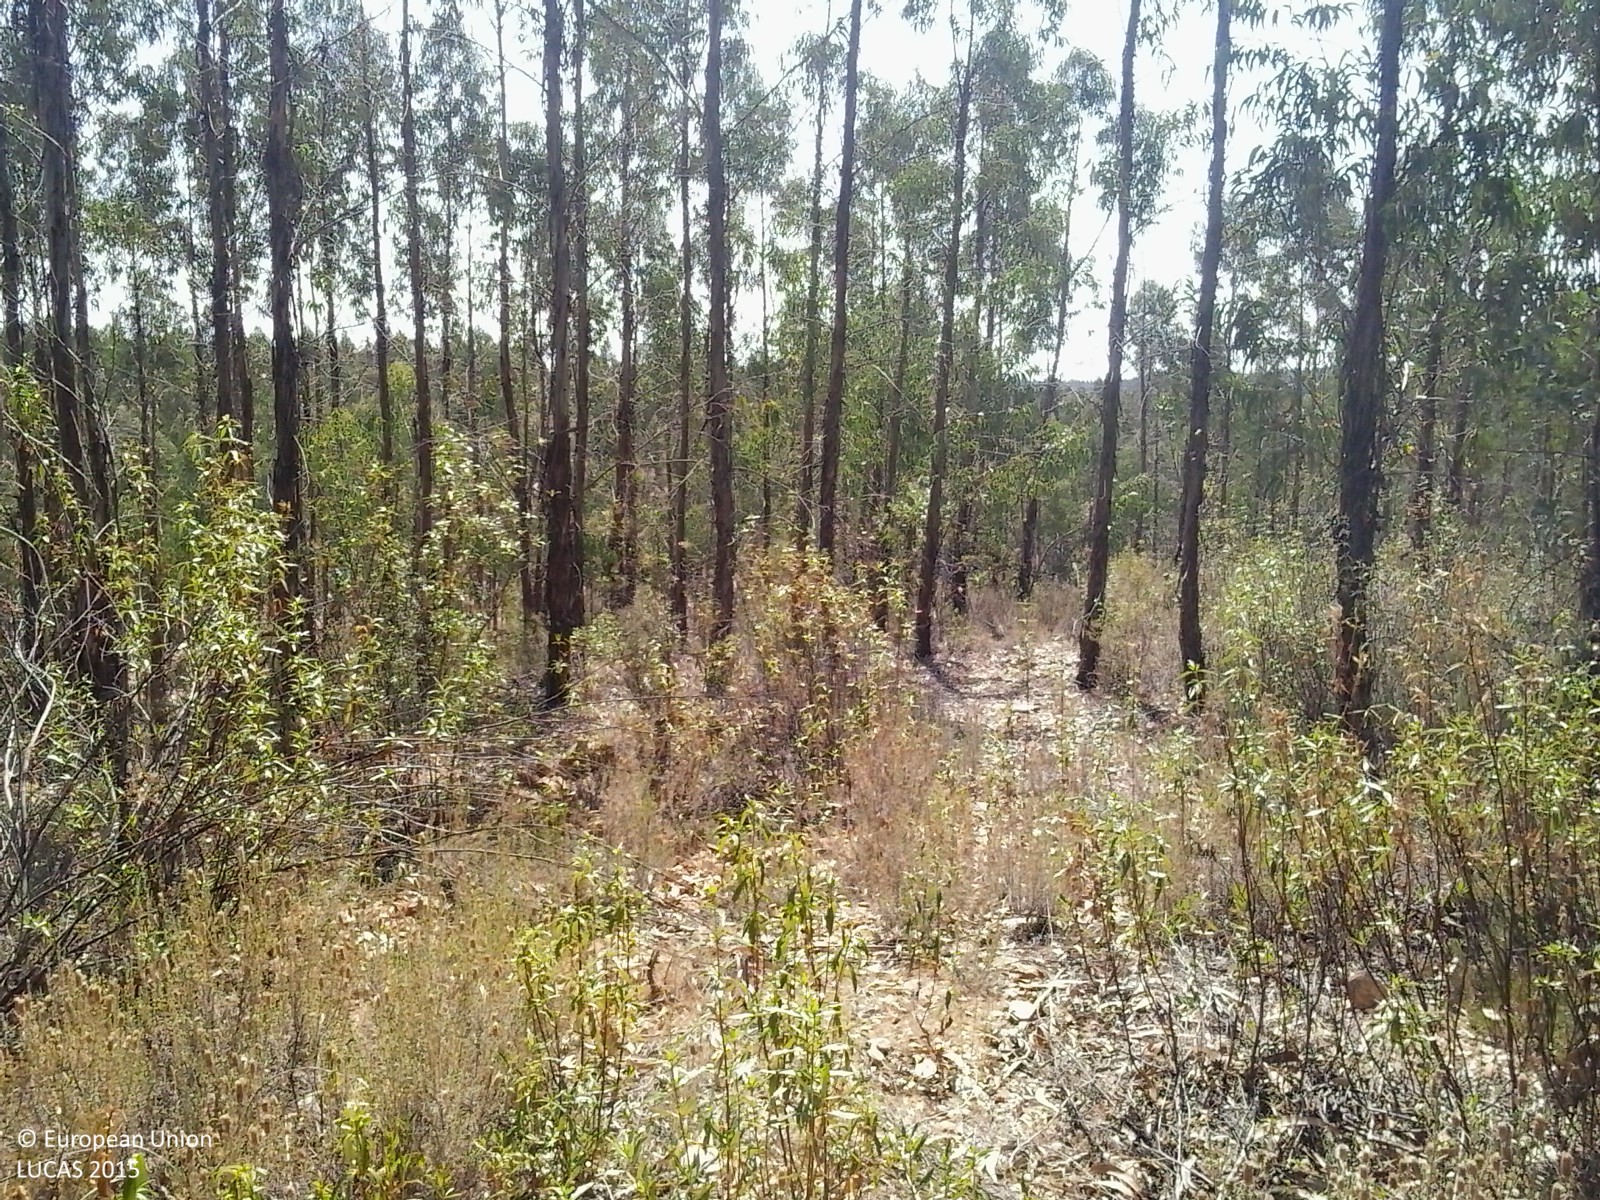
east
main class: Woodland
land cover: Broadleaved woodland
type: exotic forest
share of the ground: 25 - 50 %
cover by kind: broadleaved forest trees 45 %, shrubs 25 %, herbaceous plants 25 %, unconsolidated bare surface 5 %
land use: Forestry
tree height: > 5 m
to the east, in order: Broadleaved woodland; Other structural elements; Broadleaved woodland
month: July
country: ES
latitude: 37.5219
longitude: -6.4520
